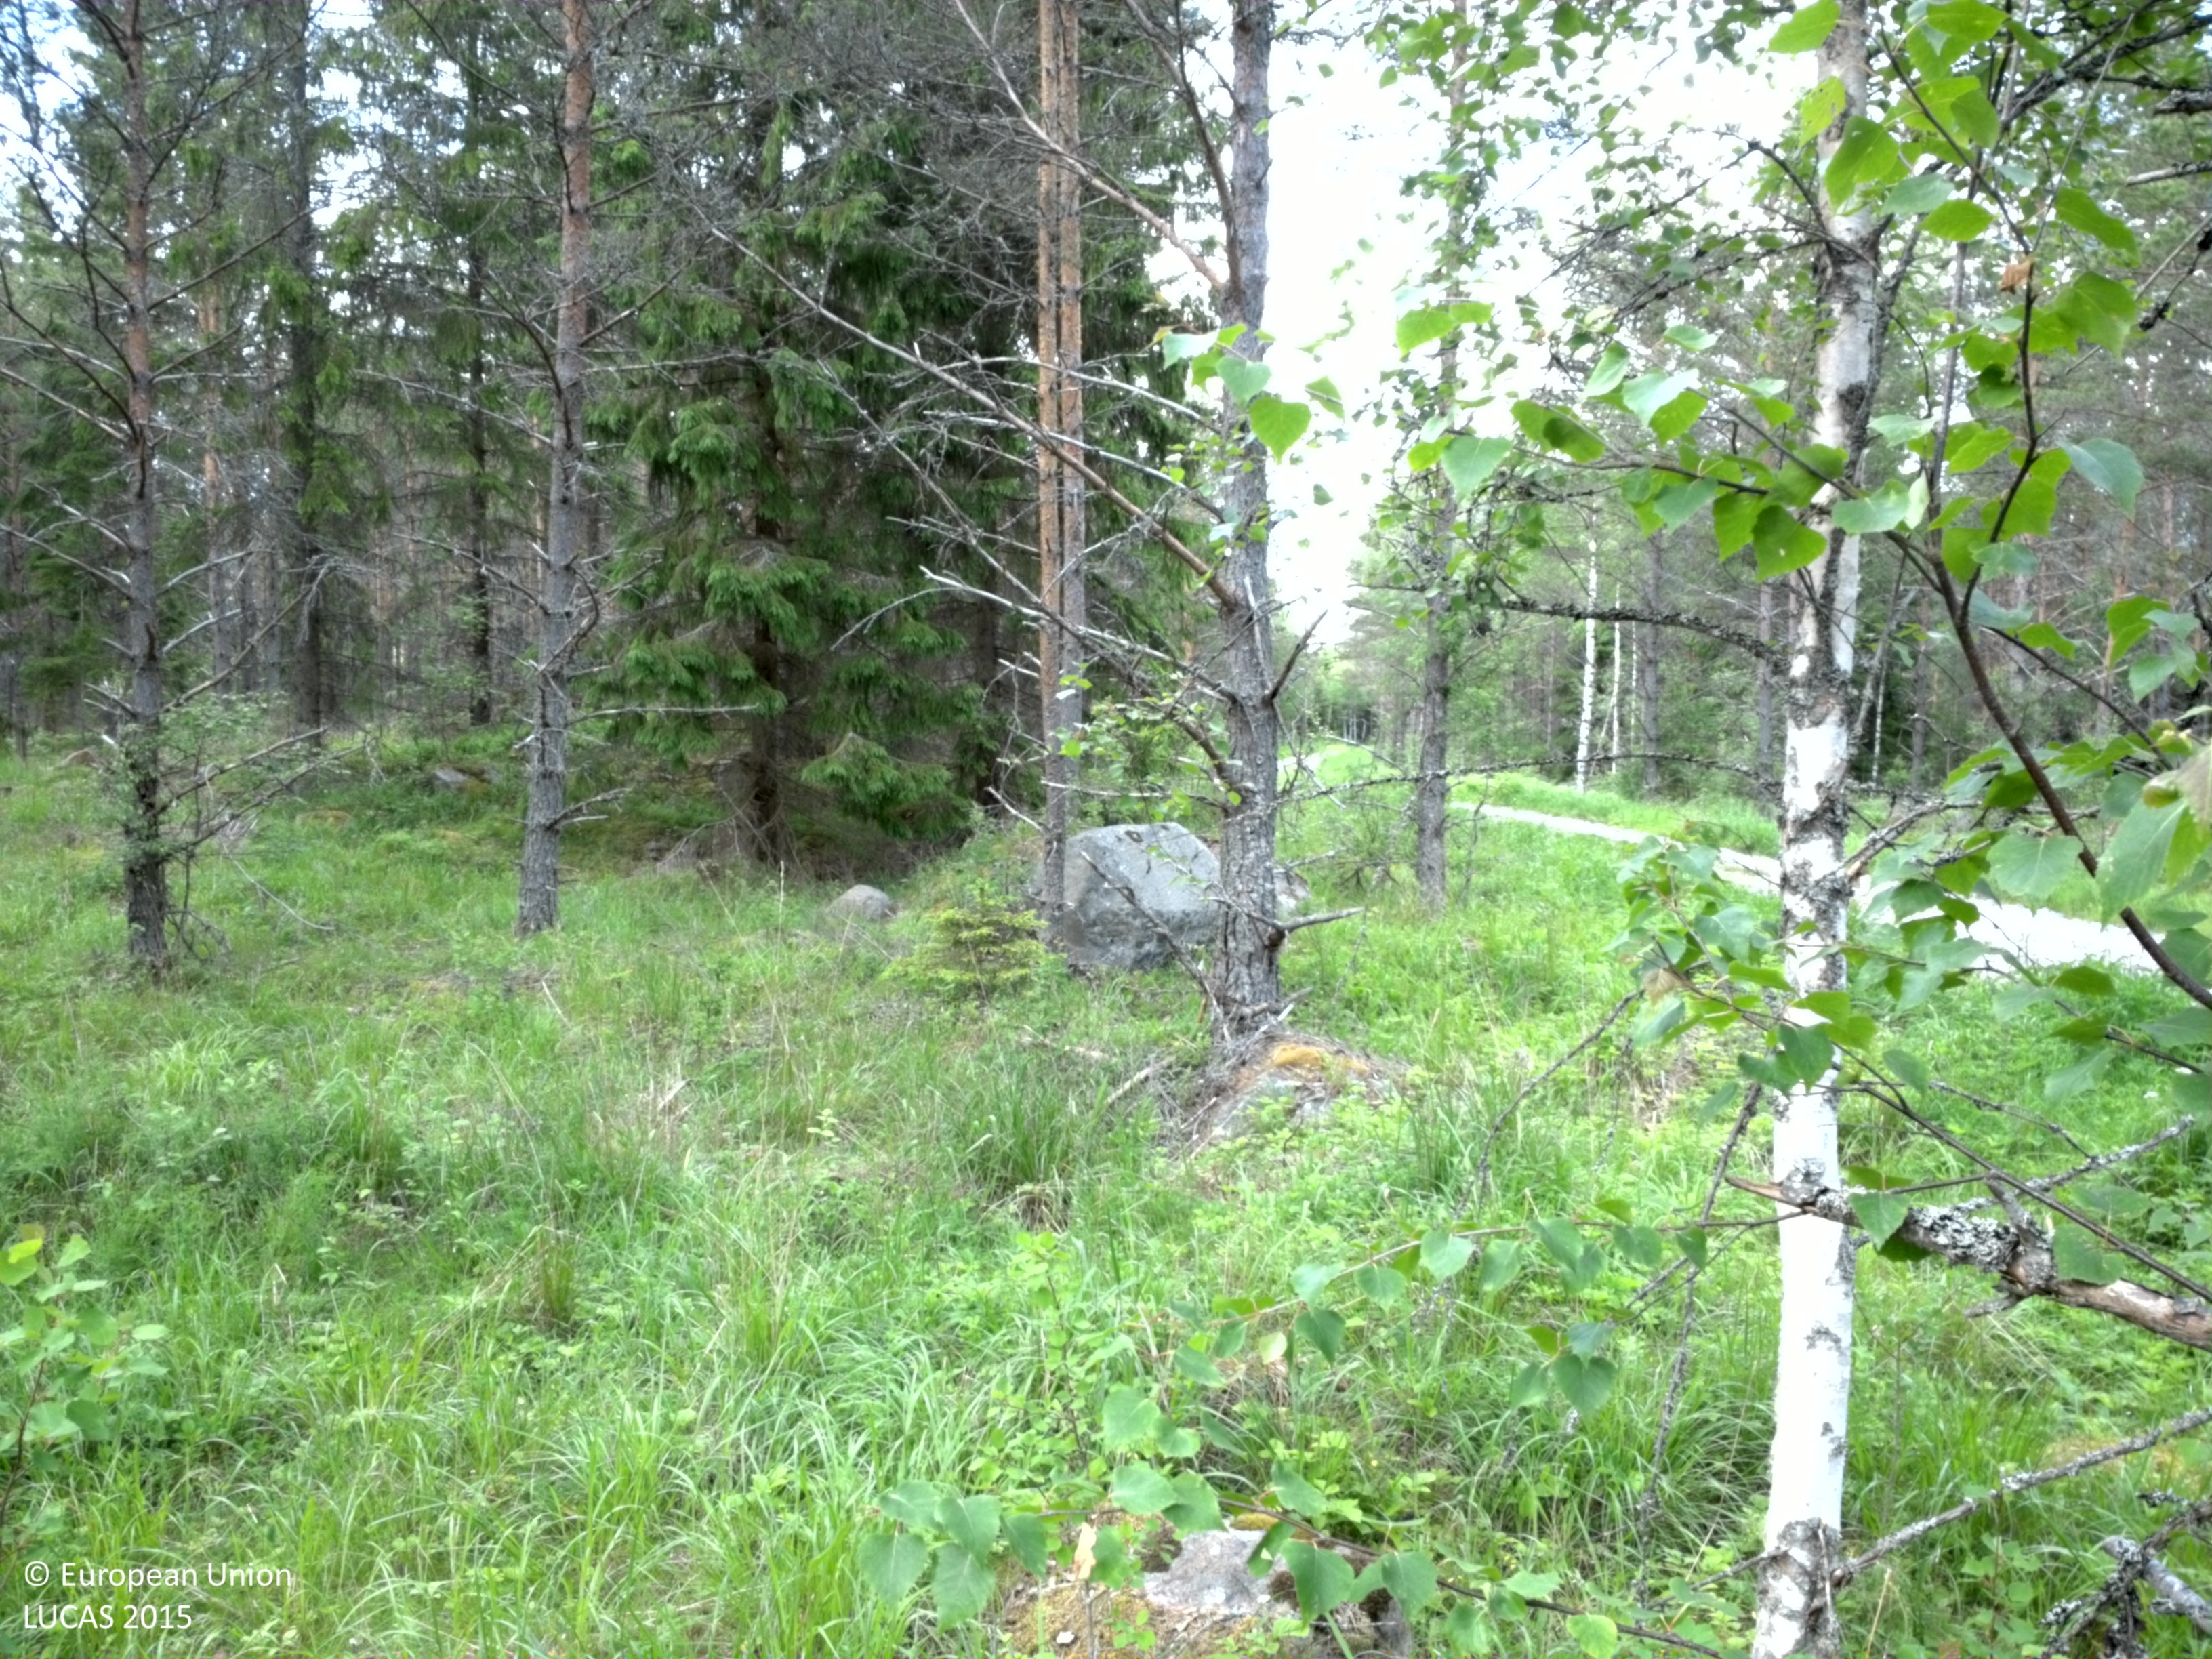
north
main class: Woodland
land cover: Pine dominated coniferous woodland
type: boreal forest
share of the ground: 50 - 75 %
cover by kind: coniferous forest trees 50 %, herbaceous plants 25 %, lichens and mosses 20 %, broadleaved forest trees 5 %
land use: Forestry
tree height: > 5 m
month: June
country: SE
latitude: 59.9422
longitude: 17.2058
